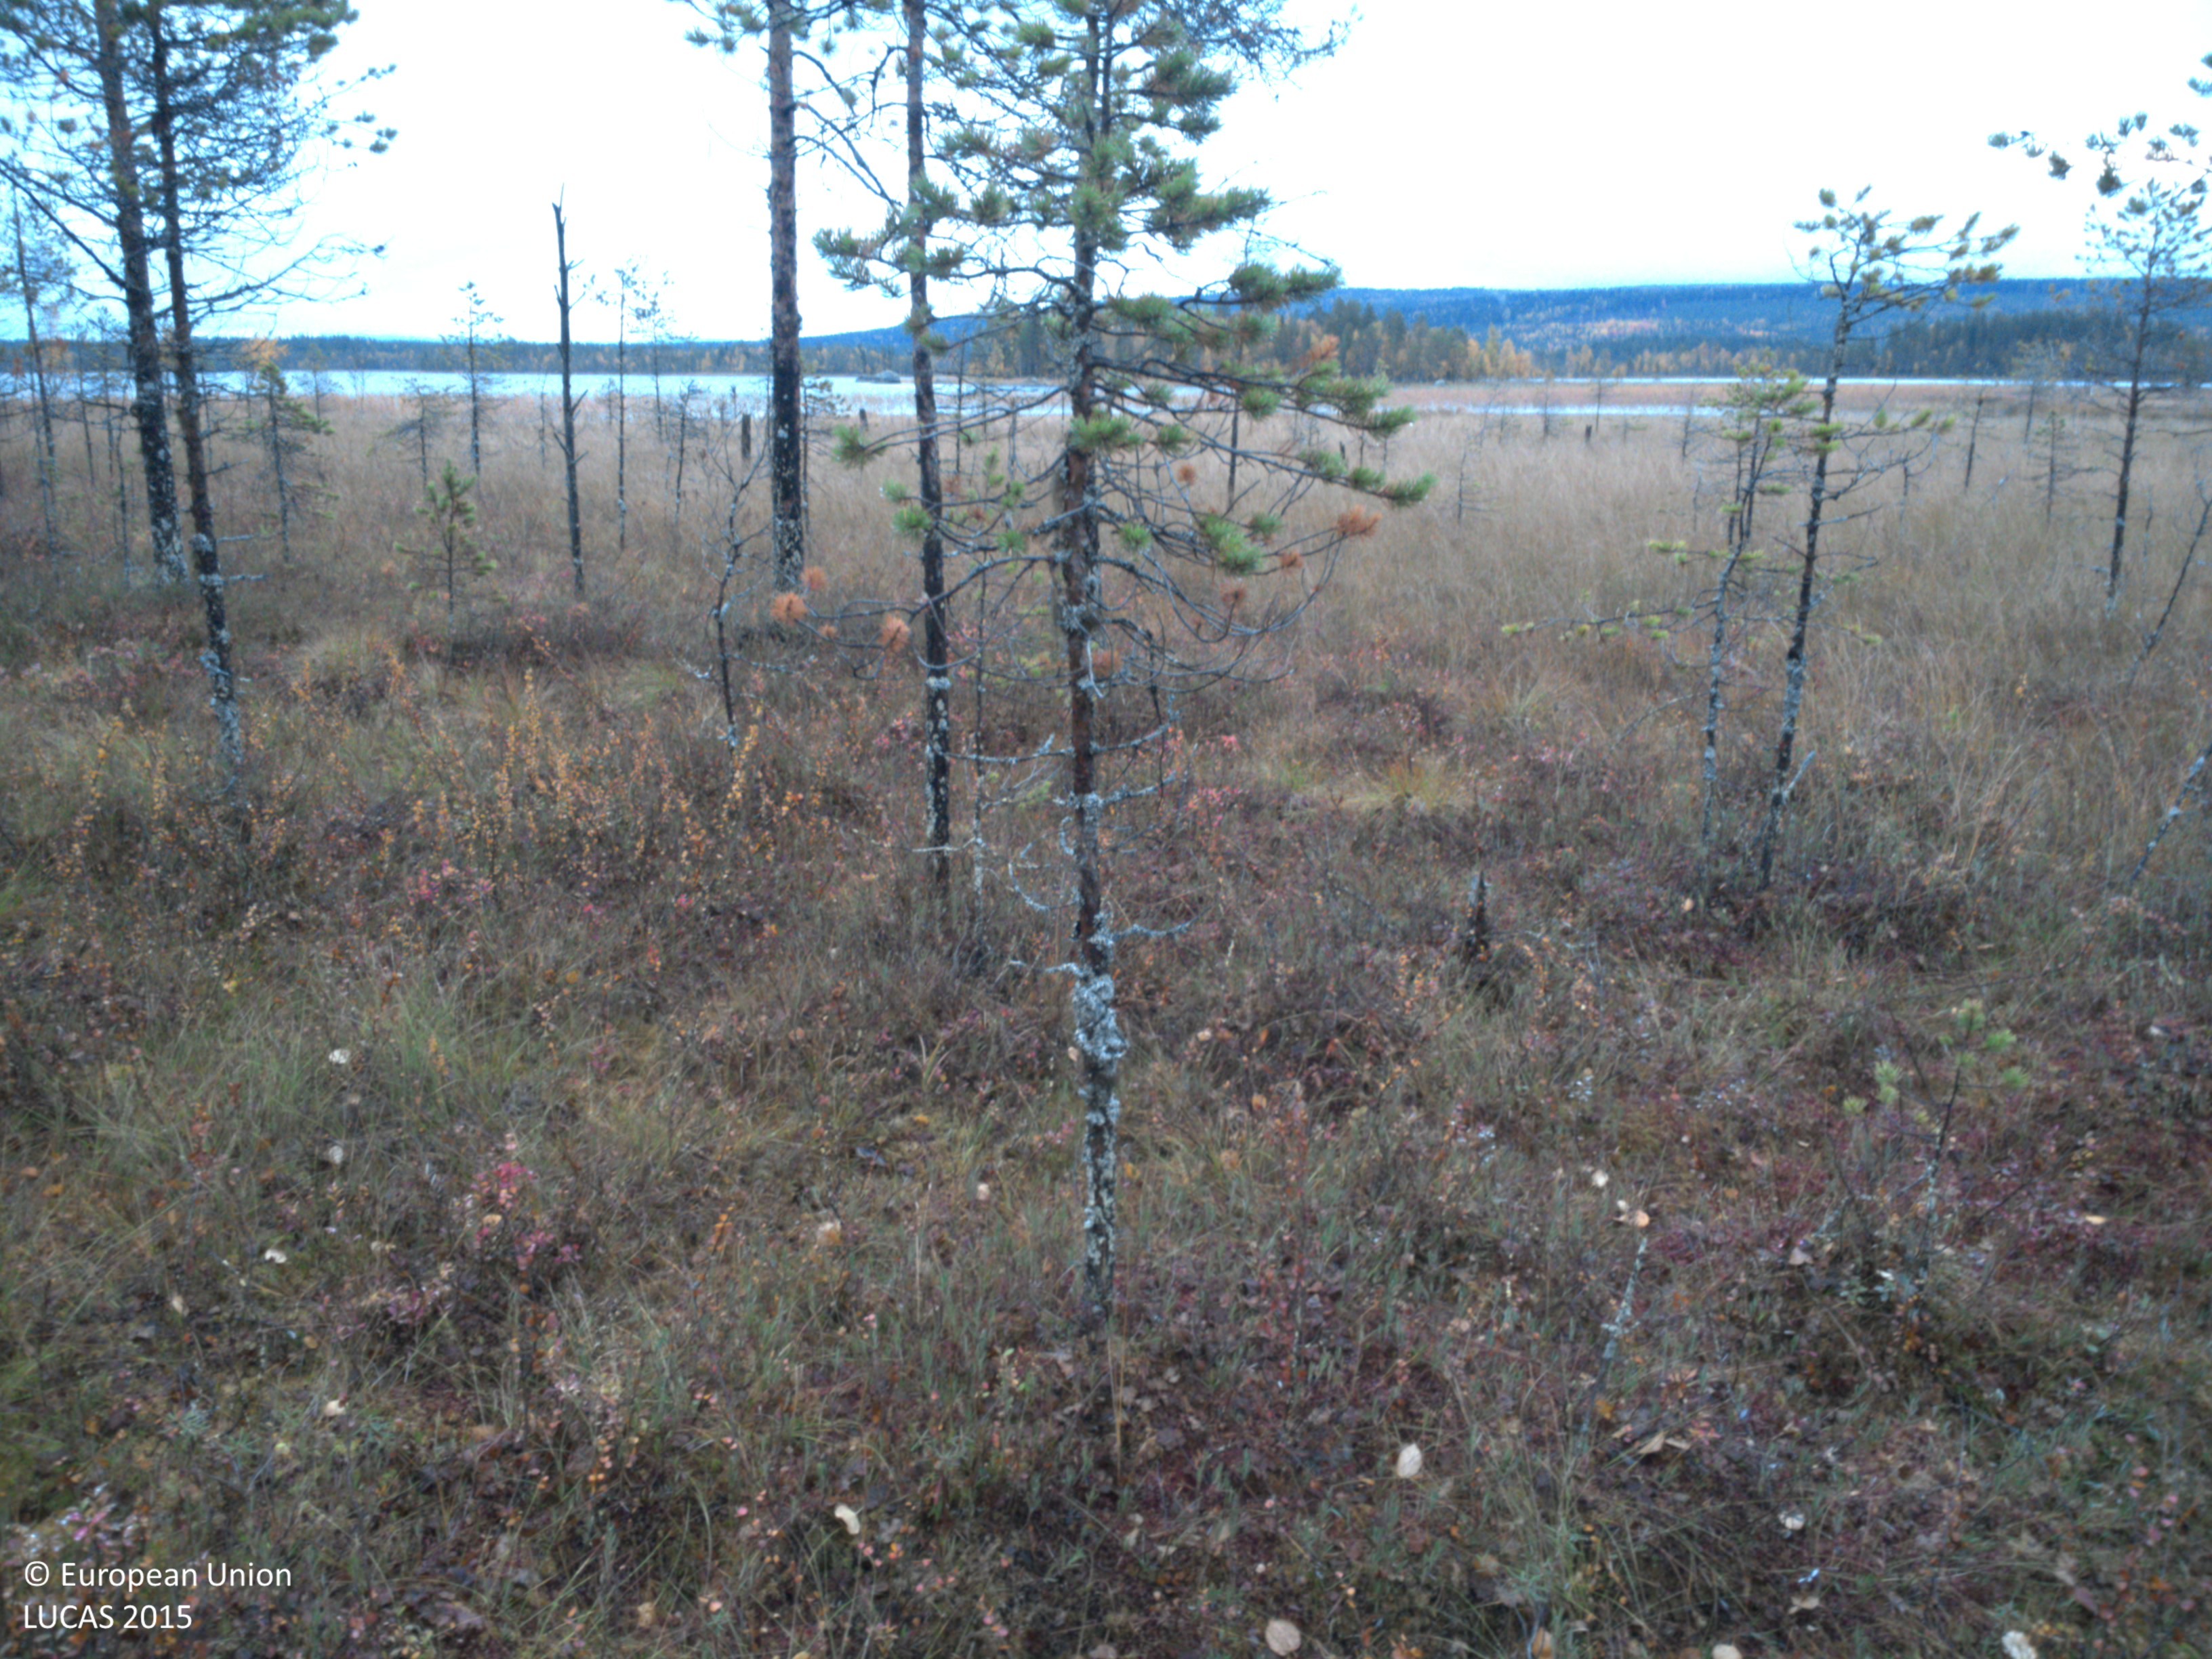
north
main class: Woodland
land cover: Pine dominated coniferous woodland
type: boreal forest
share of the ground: 25 - 50 %
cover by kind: shrubs 30 %, coniferous forest trees 25 %, herbaceous plants 20 %, lichens and mosses 20 %, broadleaved forest trees 5 %
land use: Forestry
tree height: < 5 m
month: September
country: SE
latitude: 65.0013
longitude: 18.9361
